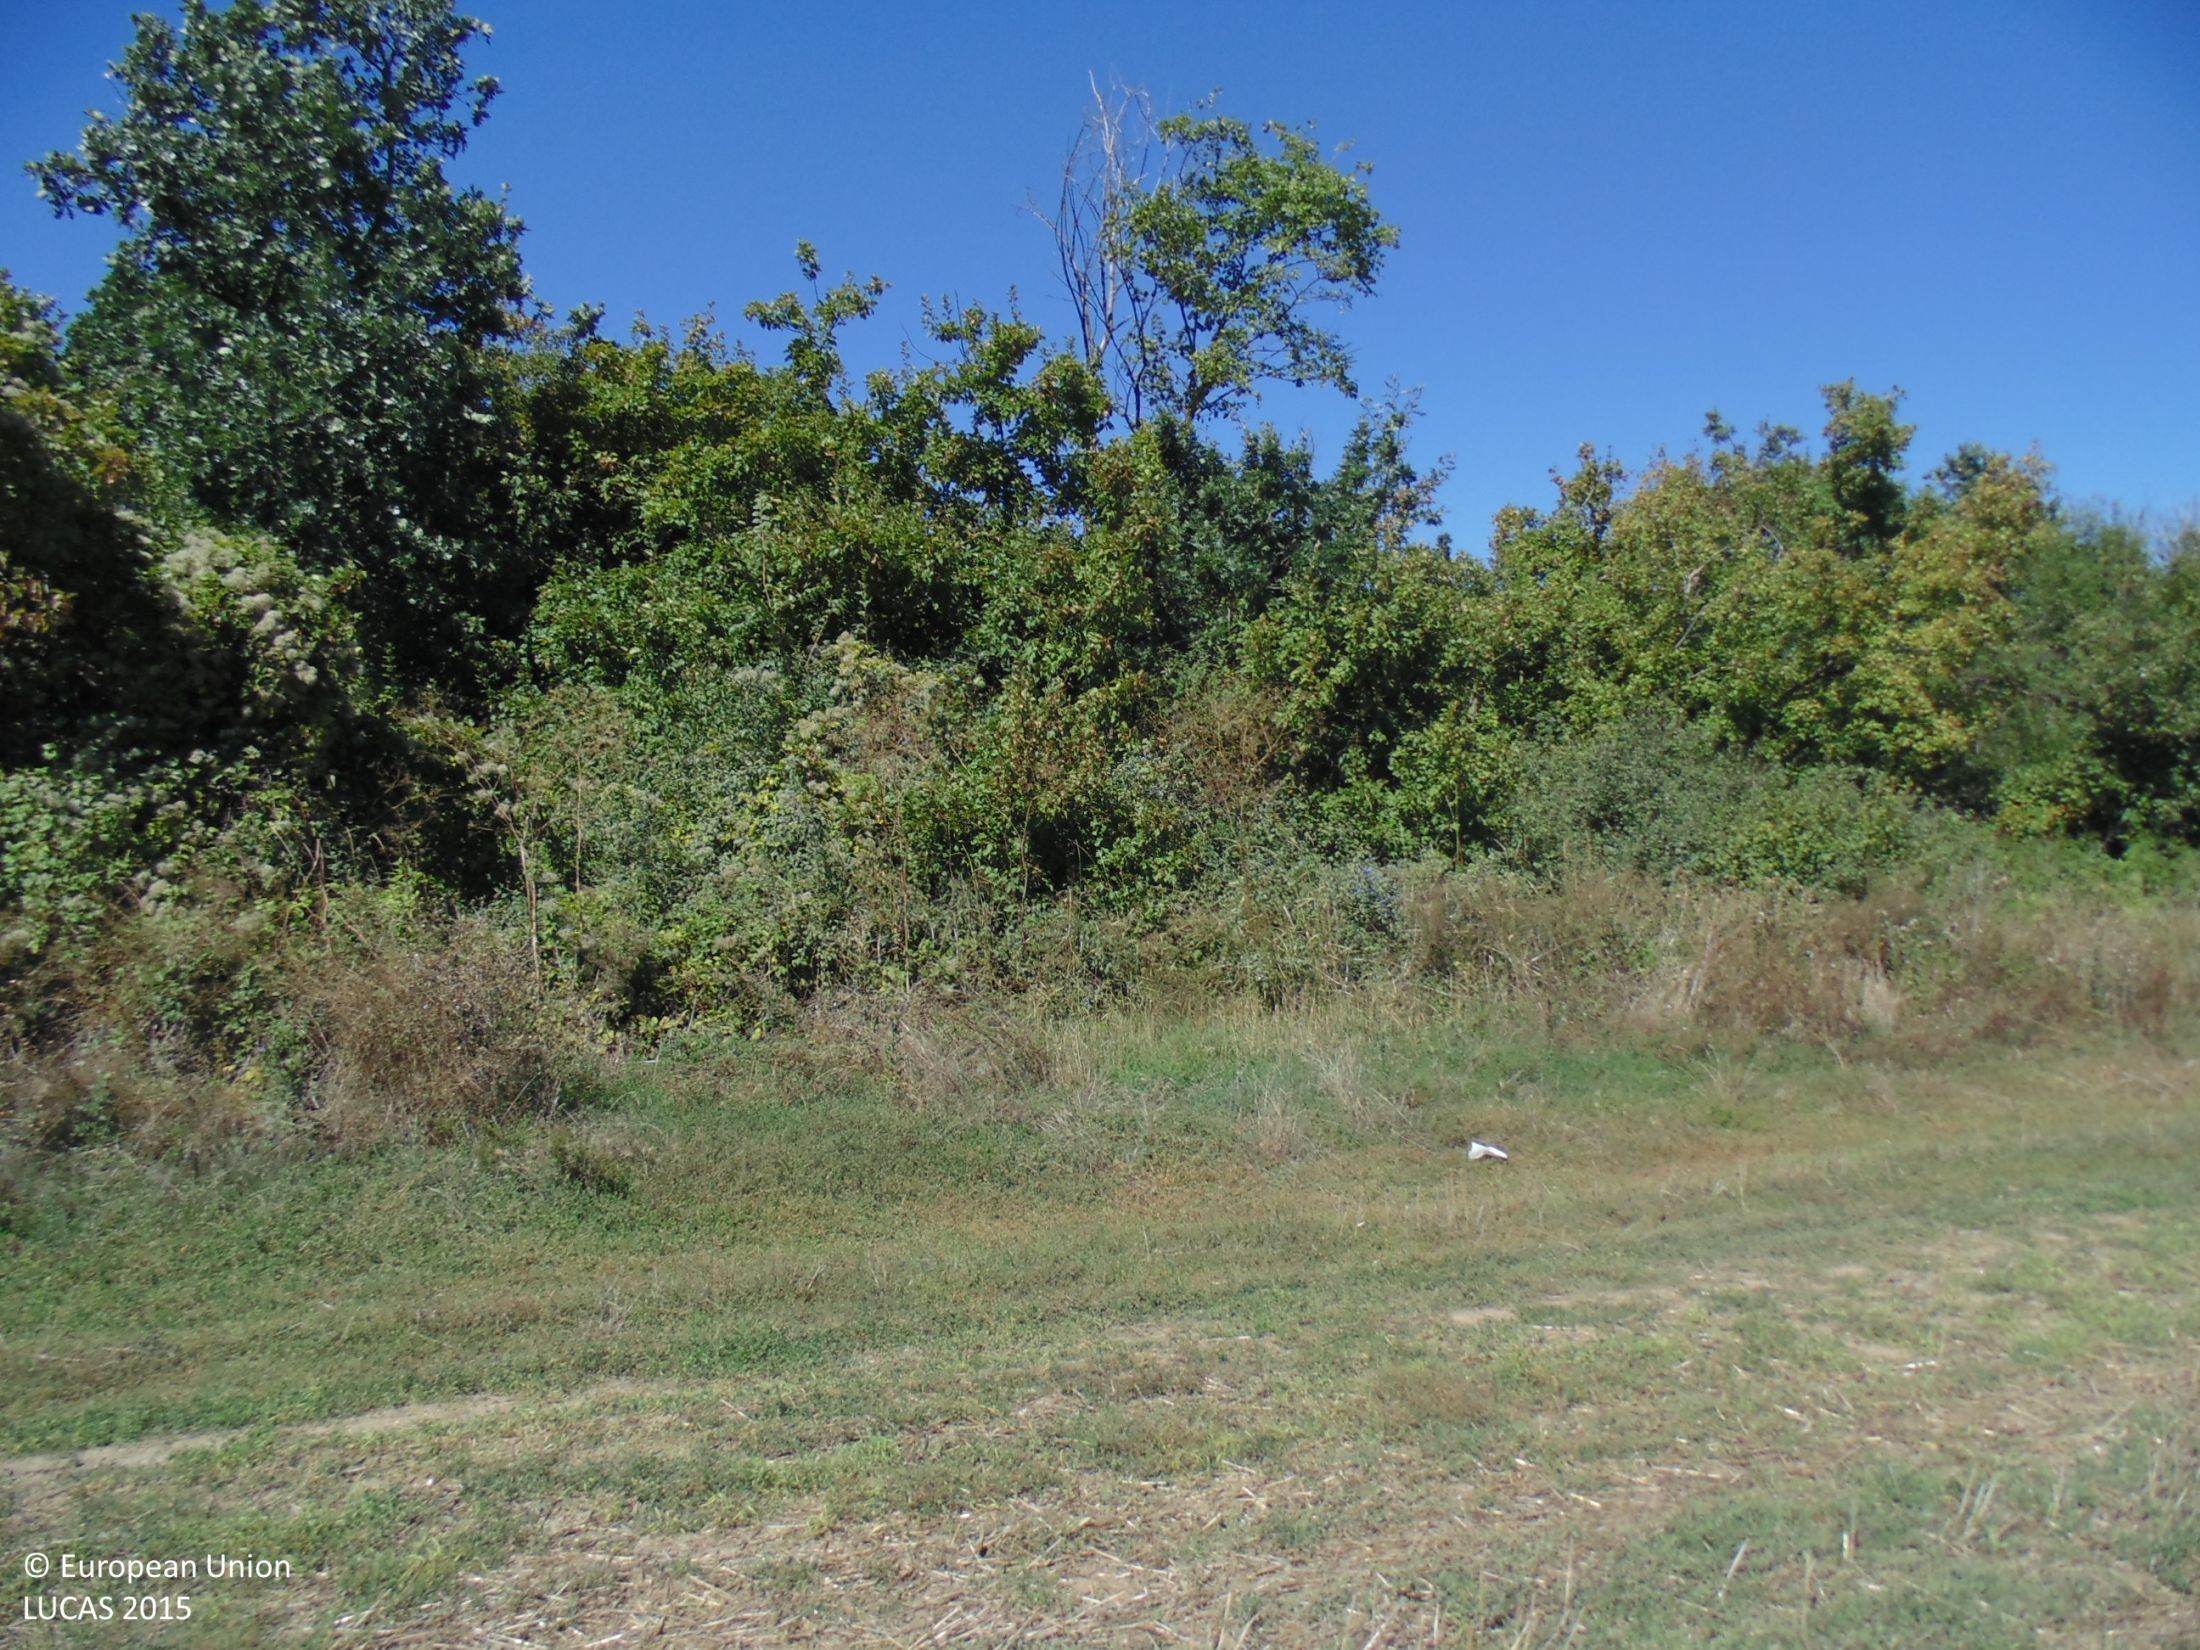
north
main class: Cropland
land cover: Common wheat
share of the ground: < 10 %
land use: Agriculture (excluding fallow land and kitchen gardens)
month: September
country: BG
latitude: 43.7333
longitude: 27.0691
